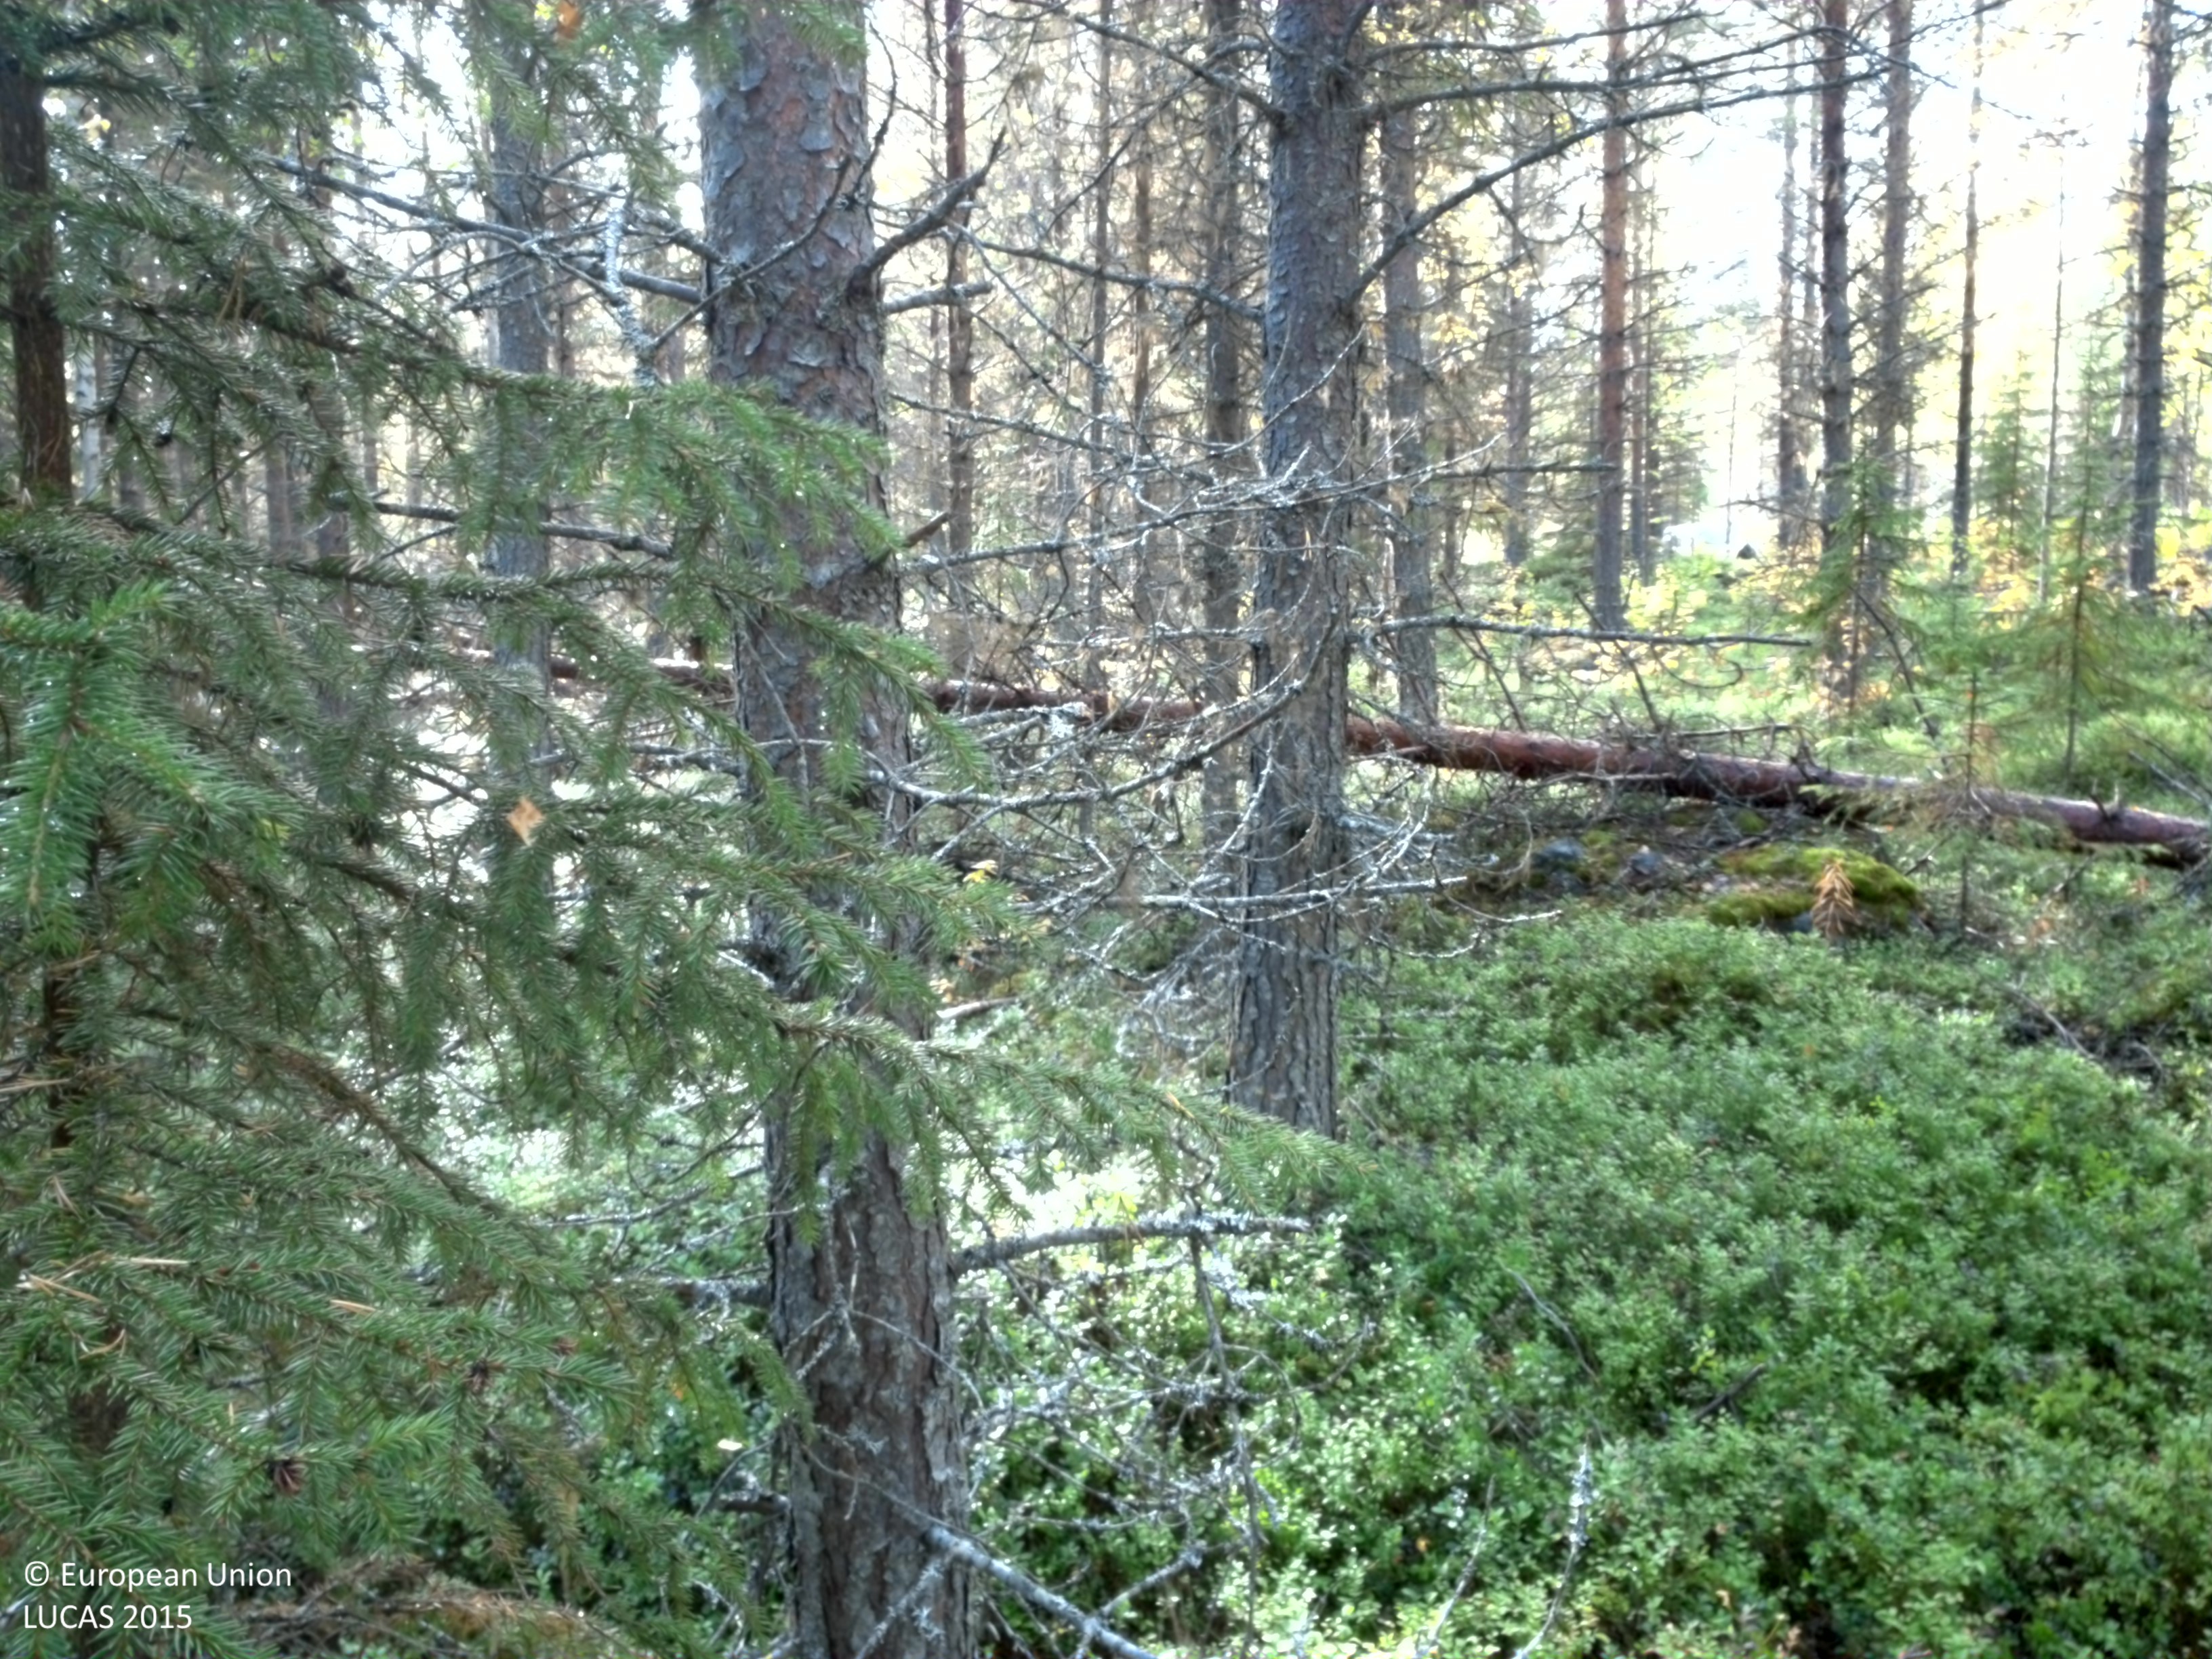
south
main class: Woodland
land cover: Pine dominated coniferous woodland
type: boreal forest
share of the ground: 25 - 50 %
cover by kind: shrubs 45 %, coniferous forest trees 30 %, herbaceous plants 10 %, lichens and mosses 10 %, broadleaved forest trees 5 %
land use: Forestry
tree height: > 5 m
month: September
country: SE
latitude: 65.2180
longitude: 16.6979
